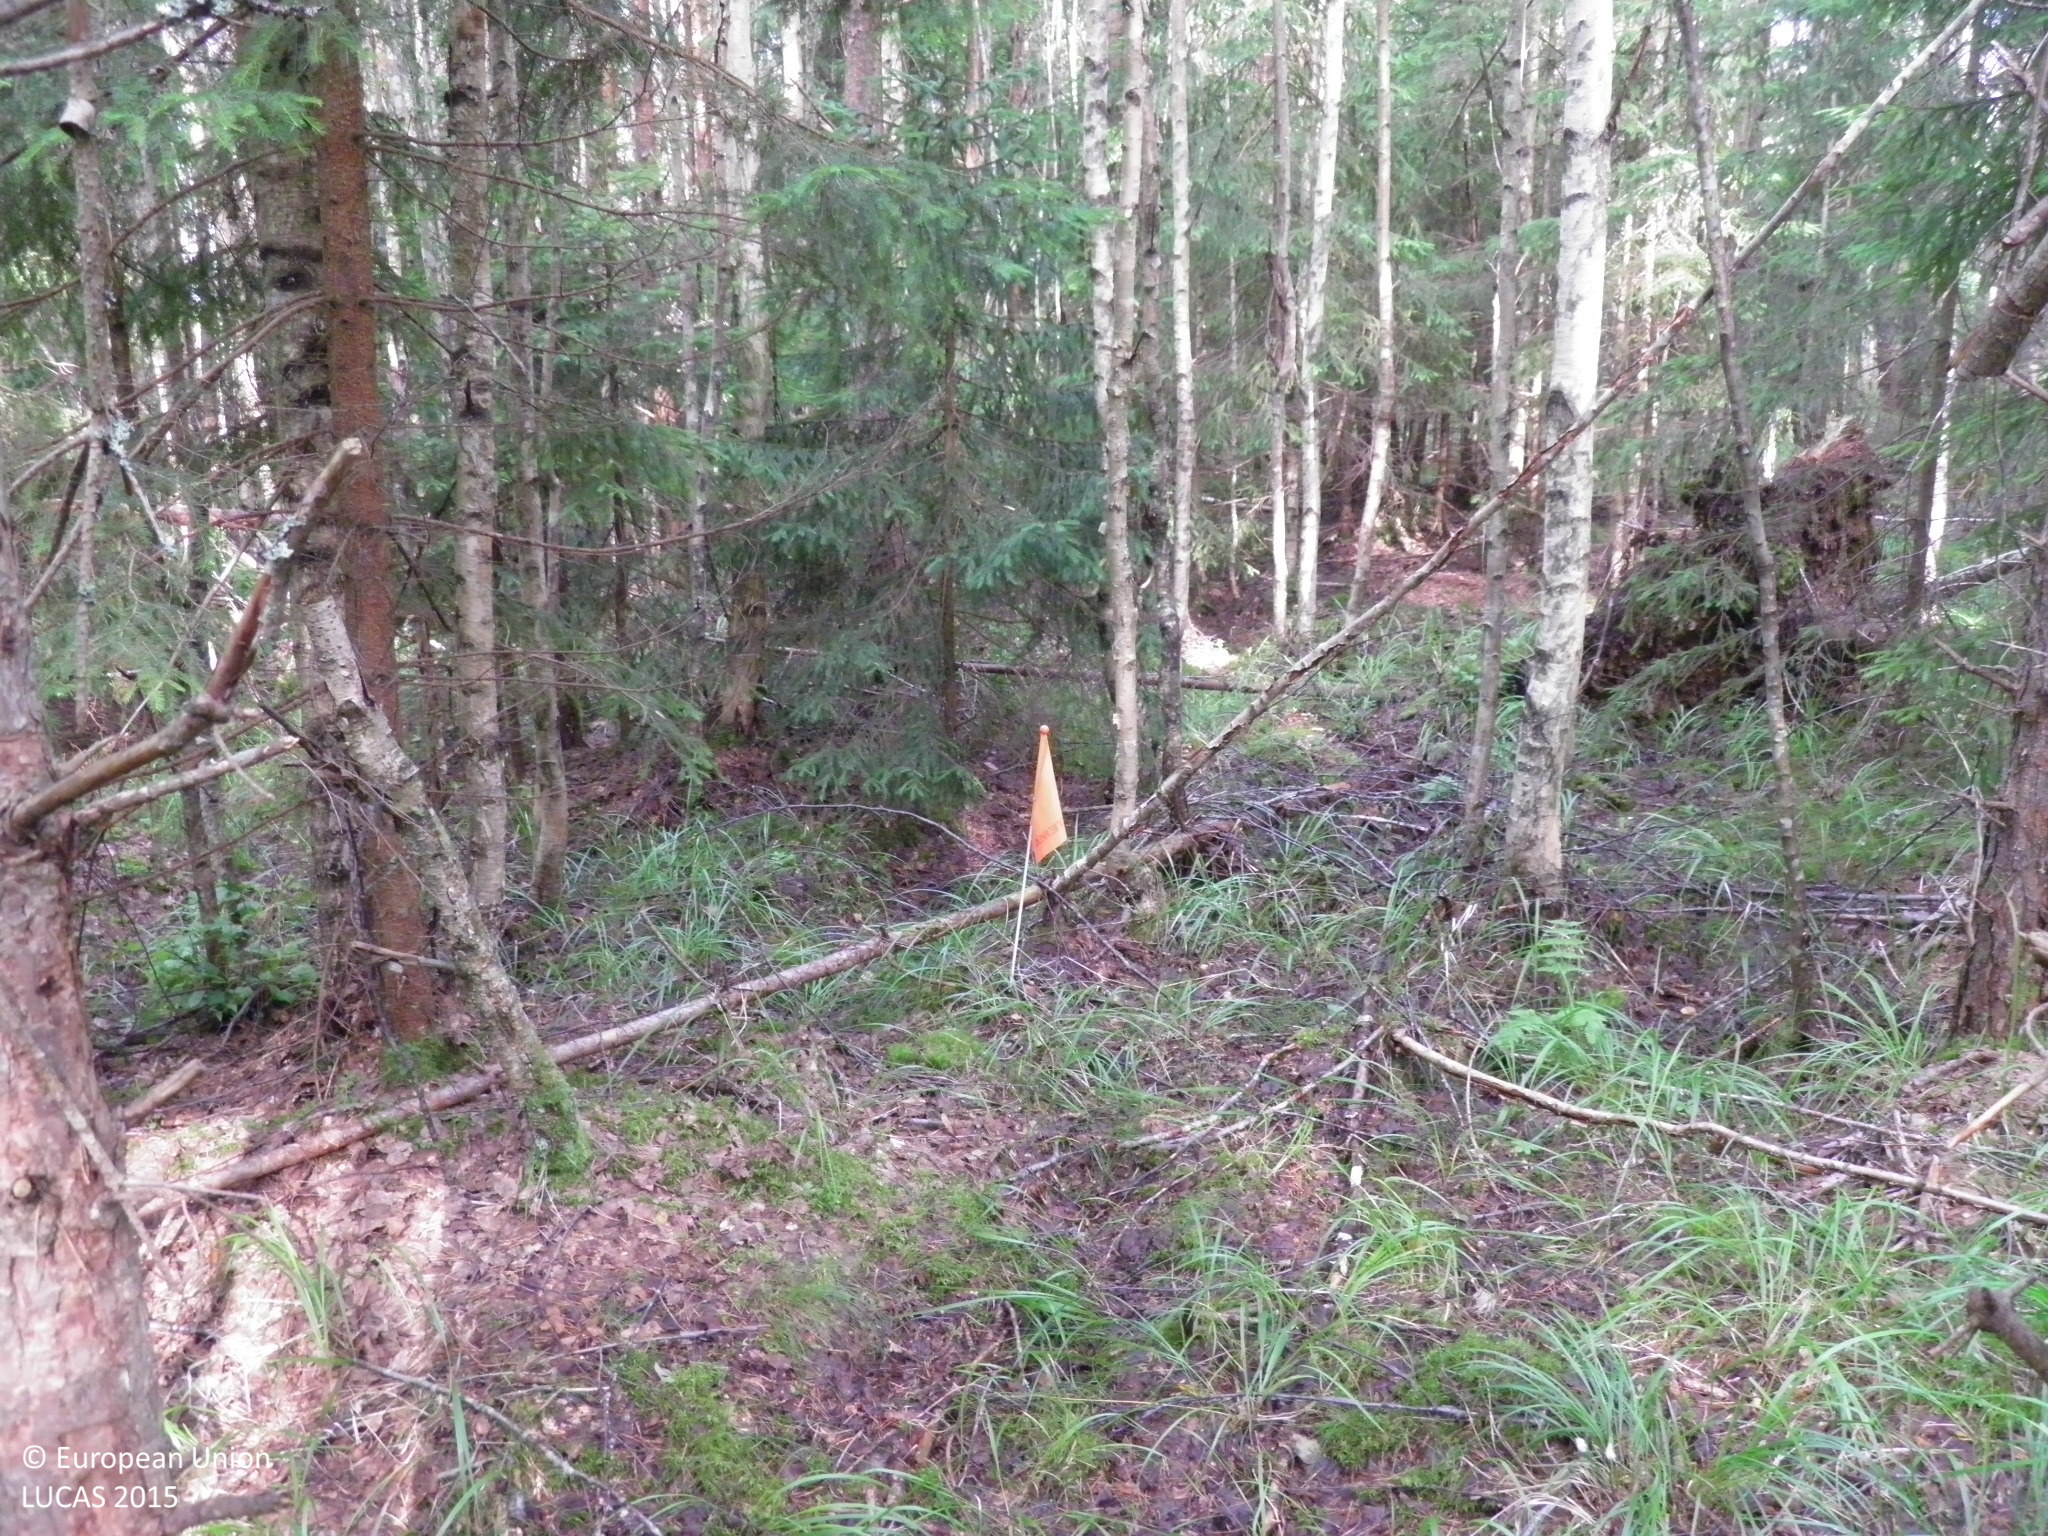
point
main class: Woodland
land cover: Pine dominated mixed woodland
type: hemiboreal forest and nemoral coniferous forest and mixed broadleaved-coniferous forest
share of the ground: > 75 %
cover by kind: broadleaved forest trees 50 %, coniferous forest trees 40 %, herbaceous plants 5 %, unconsolidated bare surface 5 %
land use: Semi-natural and natural areas not in use
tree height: > 5 m
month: July
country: FI
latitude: 60.7229
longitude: 22.4416
